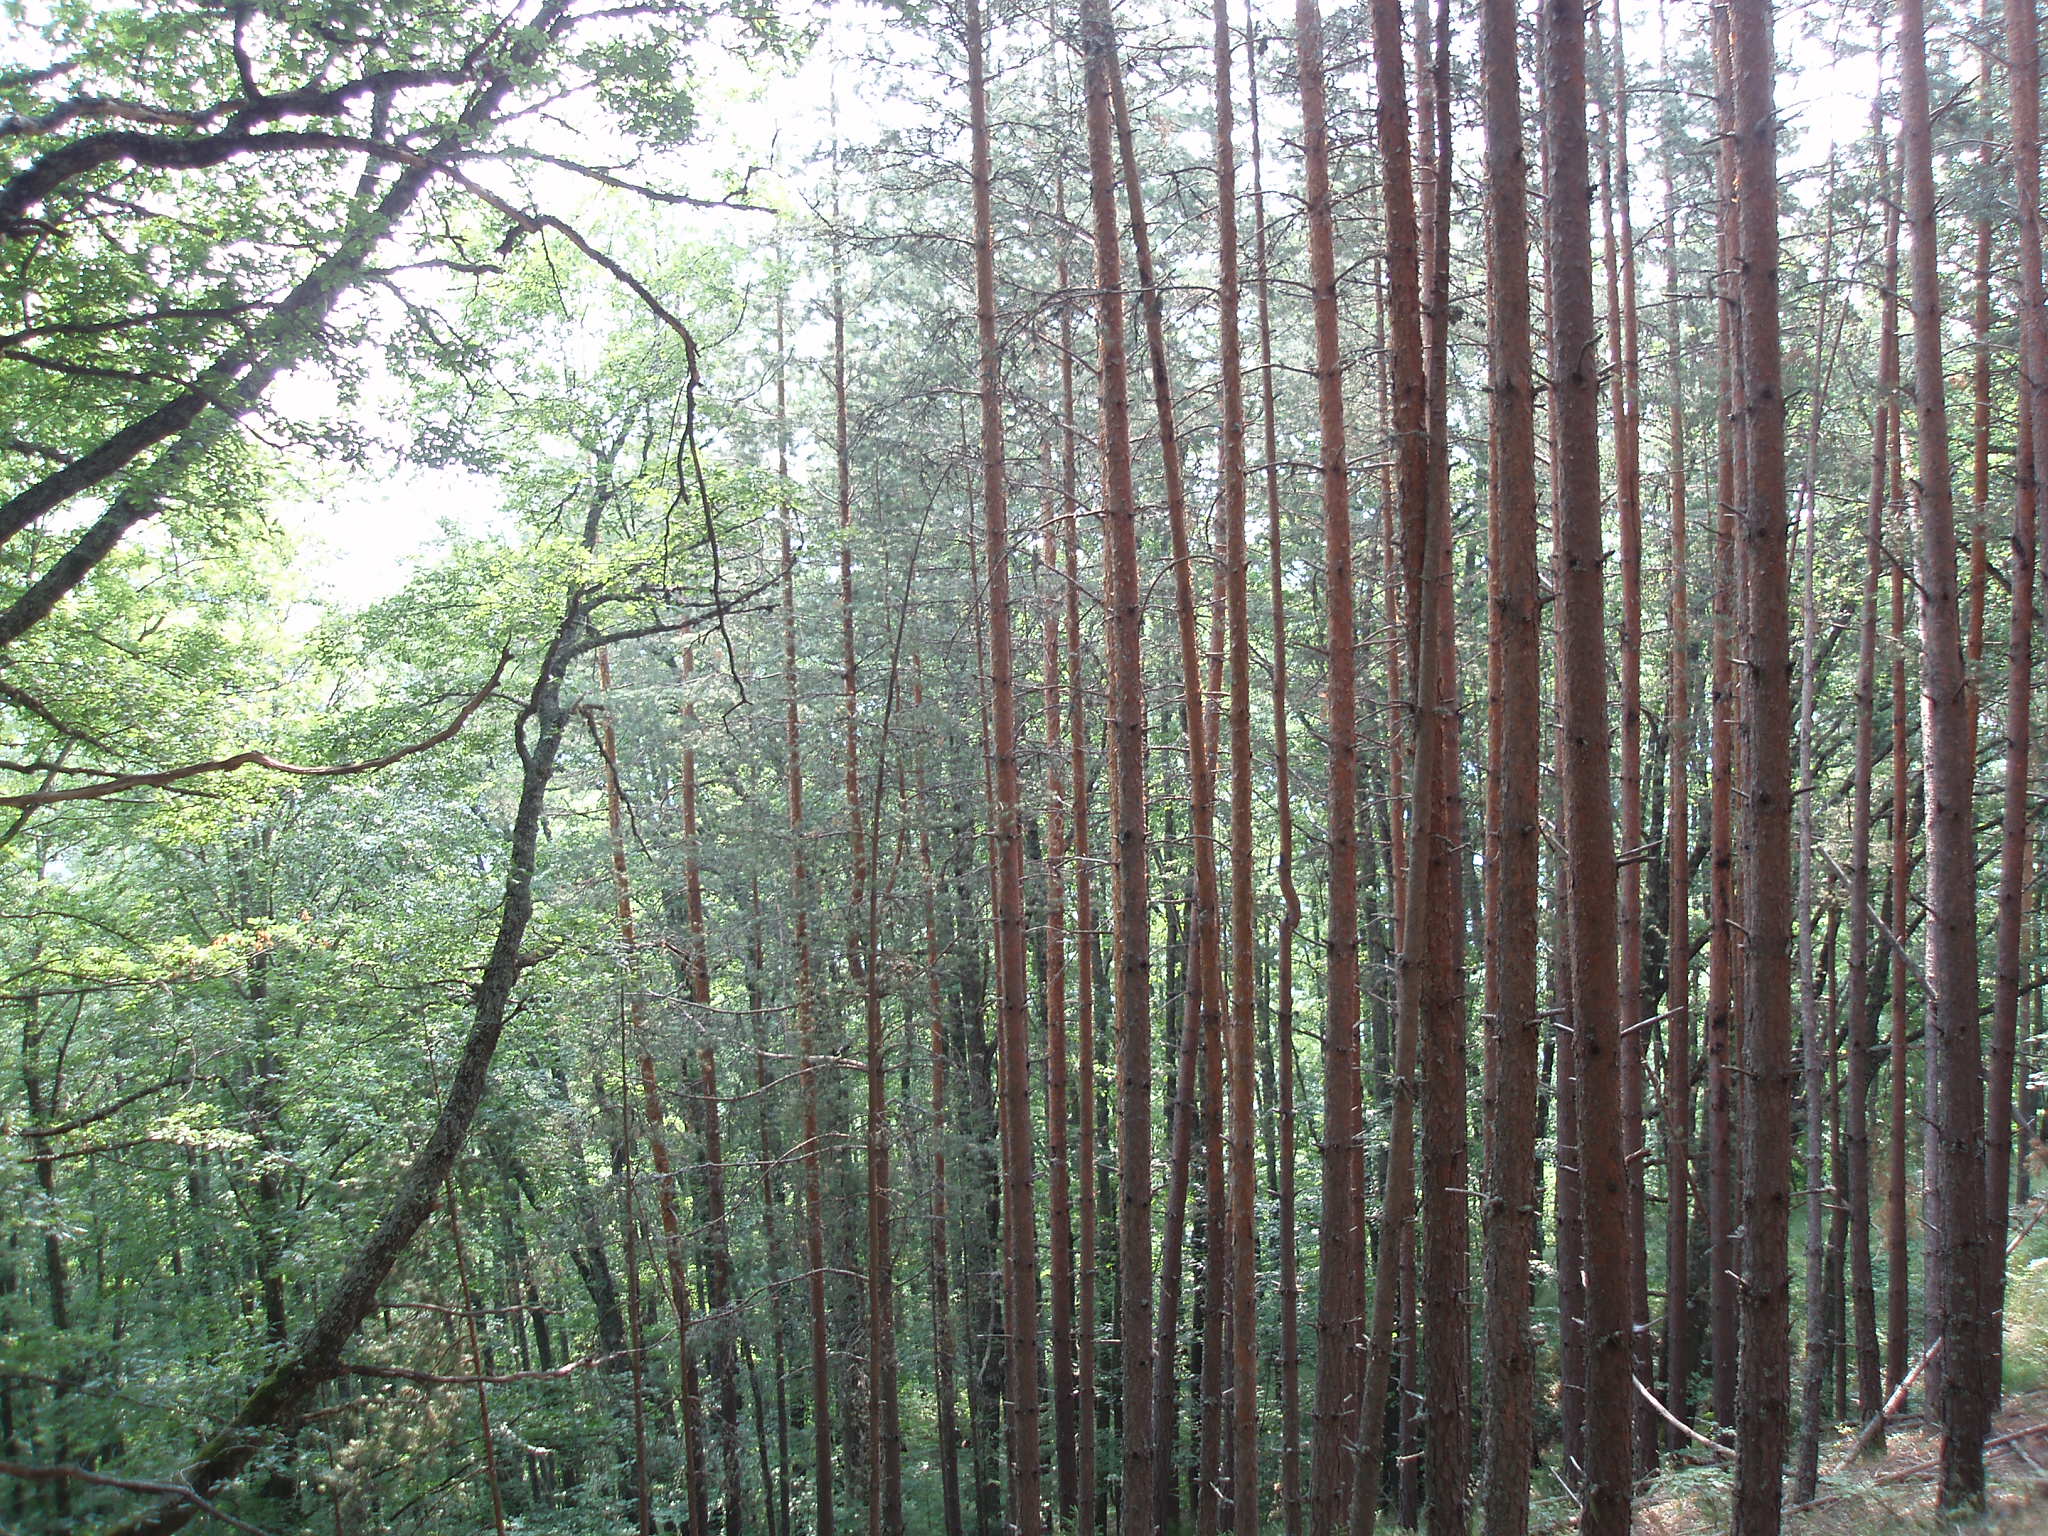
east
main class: Woodland
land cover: Pine dominated mixed woodland
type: hemiboreal forest and nemoral coniferous forest and mixed broadleaved-coniferous forest
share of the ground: > 75 %
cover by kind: coniferous forest trees 75 %, broadleaved forest trees 25 %
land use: Forestry
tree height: > 5 m
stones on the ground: > 50 %
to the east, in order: Pine dominated mixed woodland
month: July
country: BG
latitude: 42.0478
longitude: 23.6976
